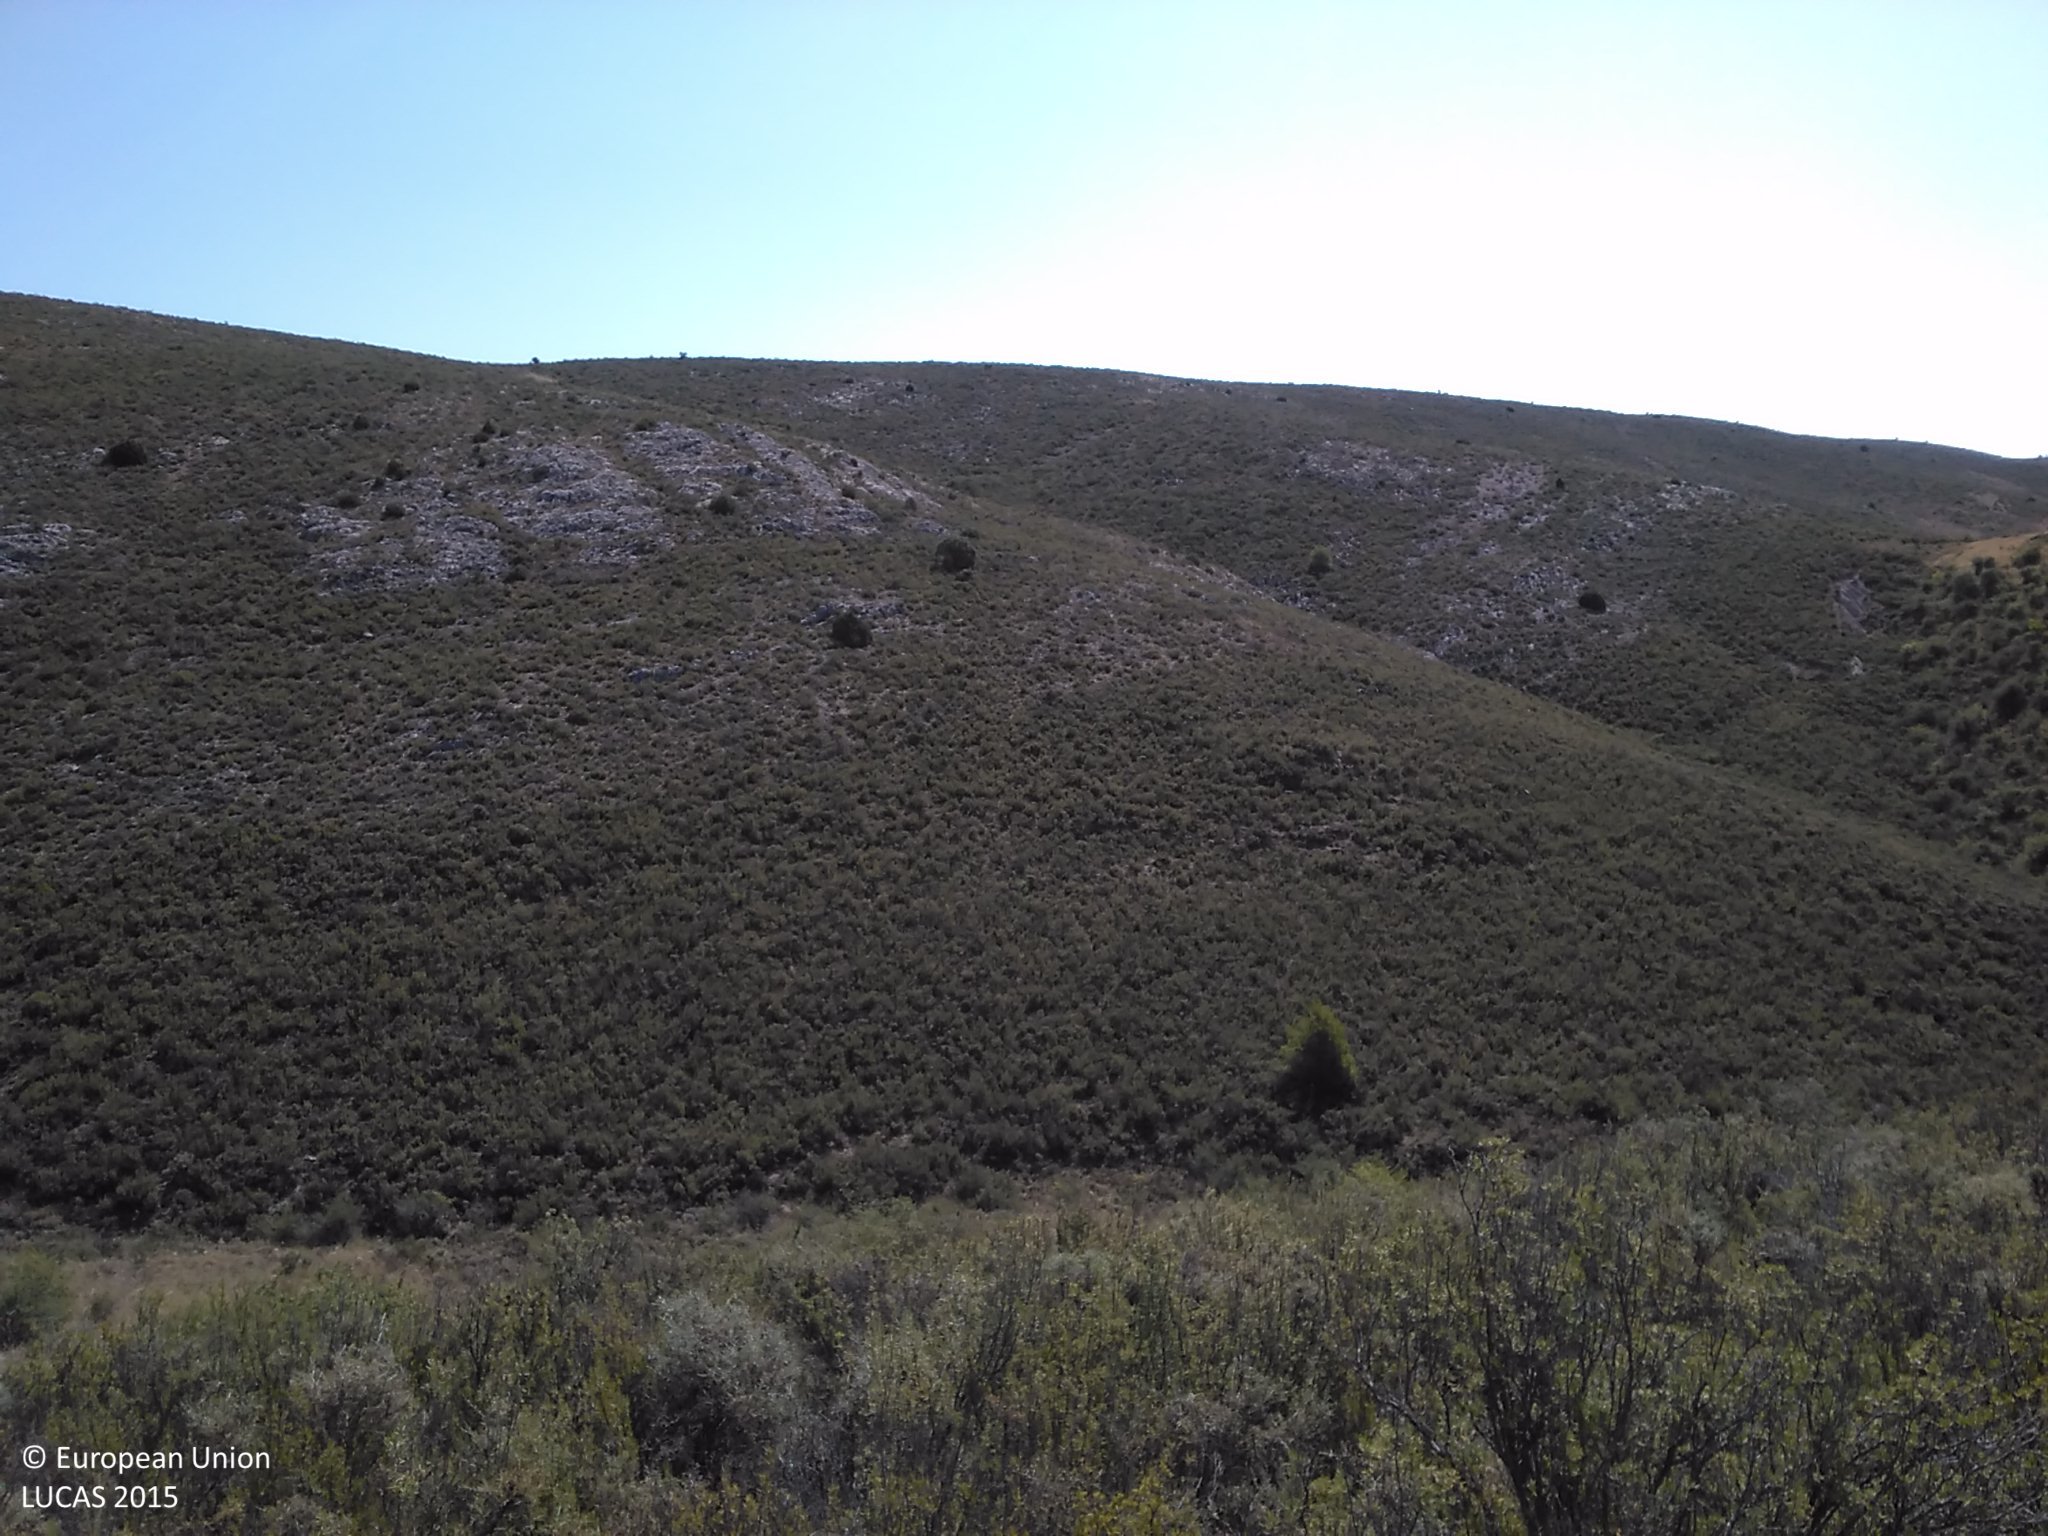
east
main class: Shrubland
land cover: Shrubland without tree cover
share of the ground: 50 - 75 %
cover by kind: shrubs 70 %, unconsolidated bare surface 25 %, herbaceous plants 5 %
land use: Semi-natural and natural areas not in use
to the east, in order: Shrubland without tree cover
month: July
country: ES
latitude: 41.4910
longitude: -1.9233
